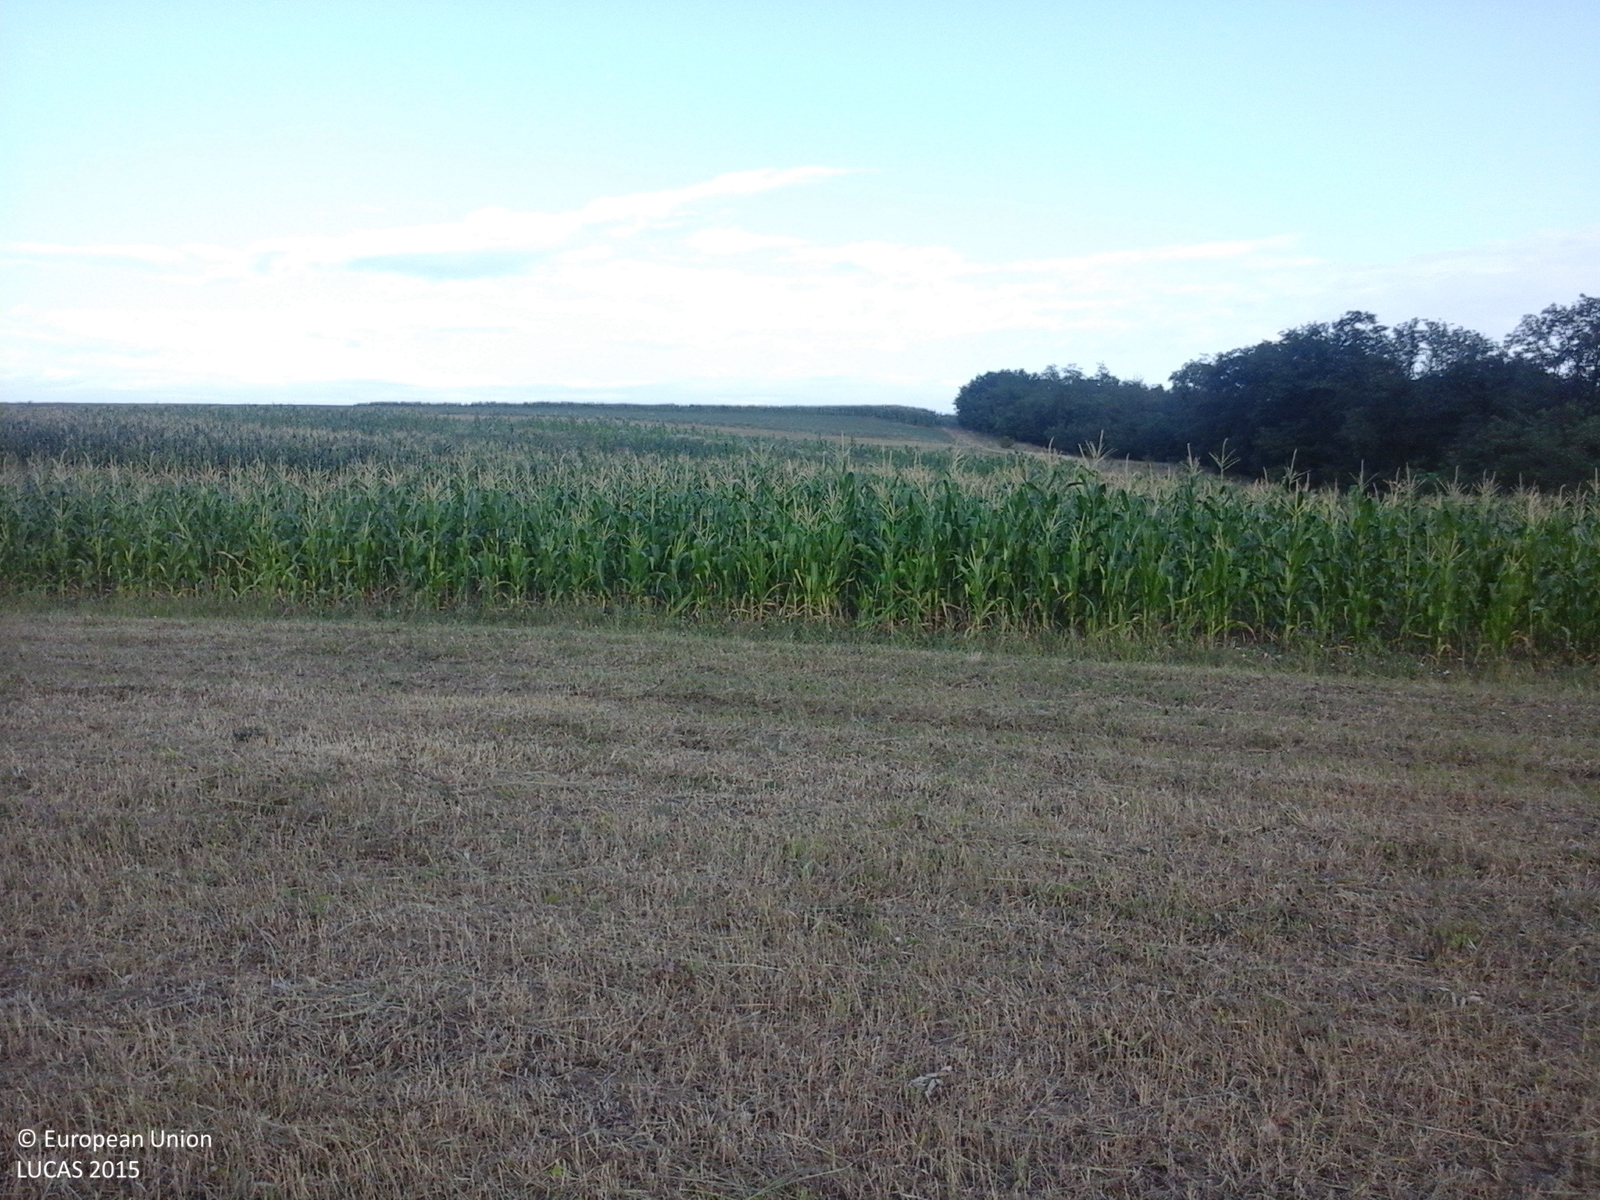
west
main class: Grassland
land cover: Grassland without tree/shrub cover
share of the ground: > 75 %
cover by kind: herbaceous plants 100 %
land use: Agriculture (excluding fallow land and kitchen gardens)
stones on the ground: < 10 %
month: July
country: RO
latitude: 46.7066
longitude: 27.2255
